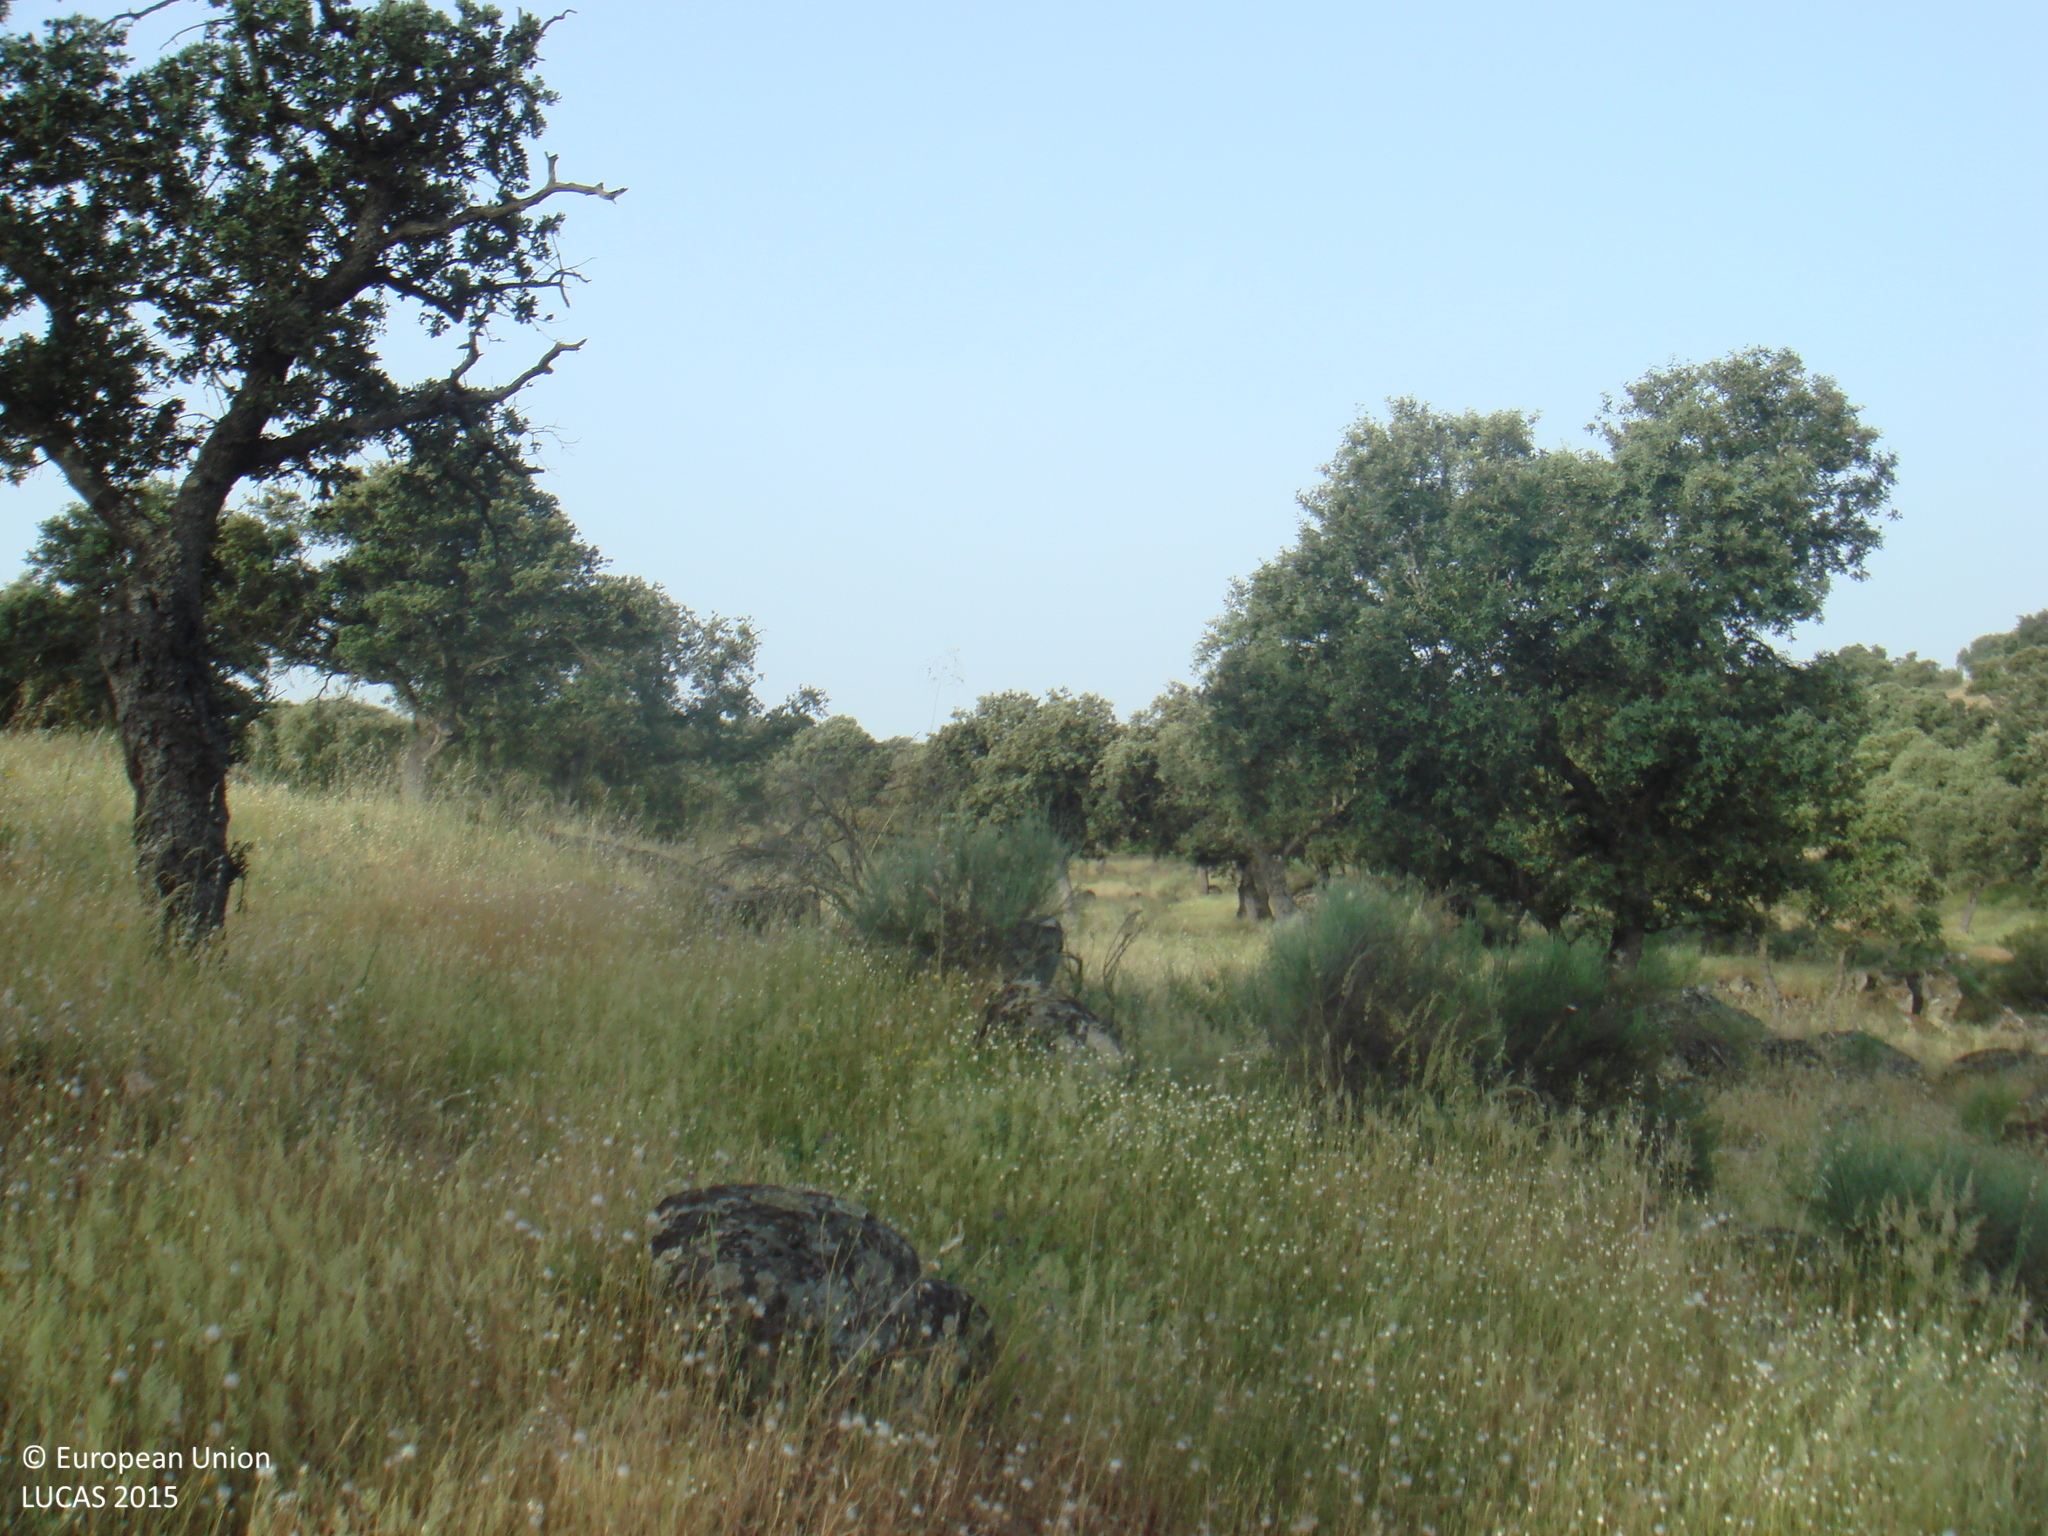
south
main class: Woodland
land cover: Broadleaved woodland
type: broadleaved evergreen forest
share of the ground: 50 - 75 %
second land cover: Spontaneously vegetated surfaces
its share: > 75 %
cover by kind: herbaceous plants 60 %, broadleaved forest trees 40 %
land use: Forestry
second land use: Agriculture (excluding fallow land and kitchen gardens)
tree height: > 5 m
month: May
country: ES
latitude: 38.4802
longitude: -4.7772
